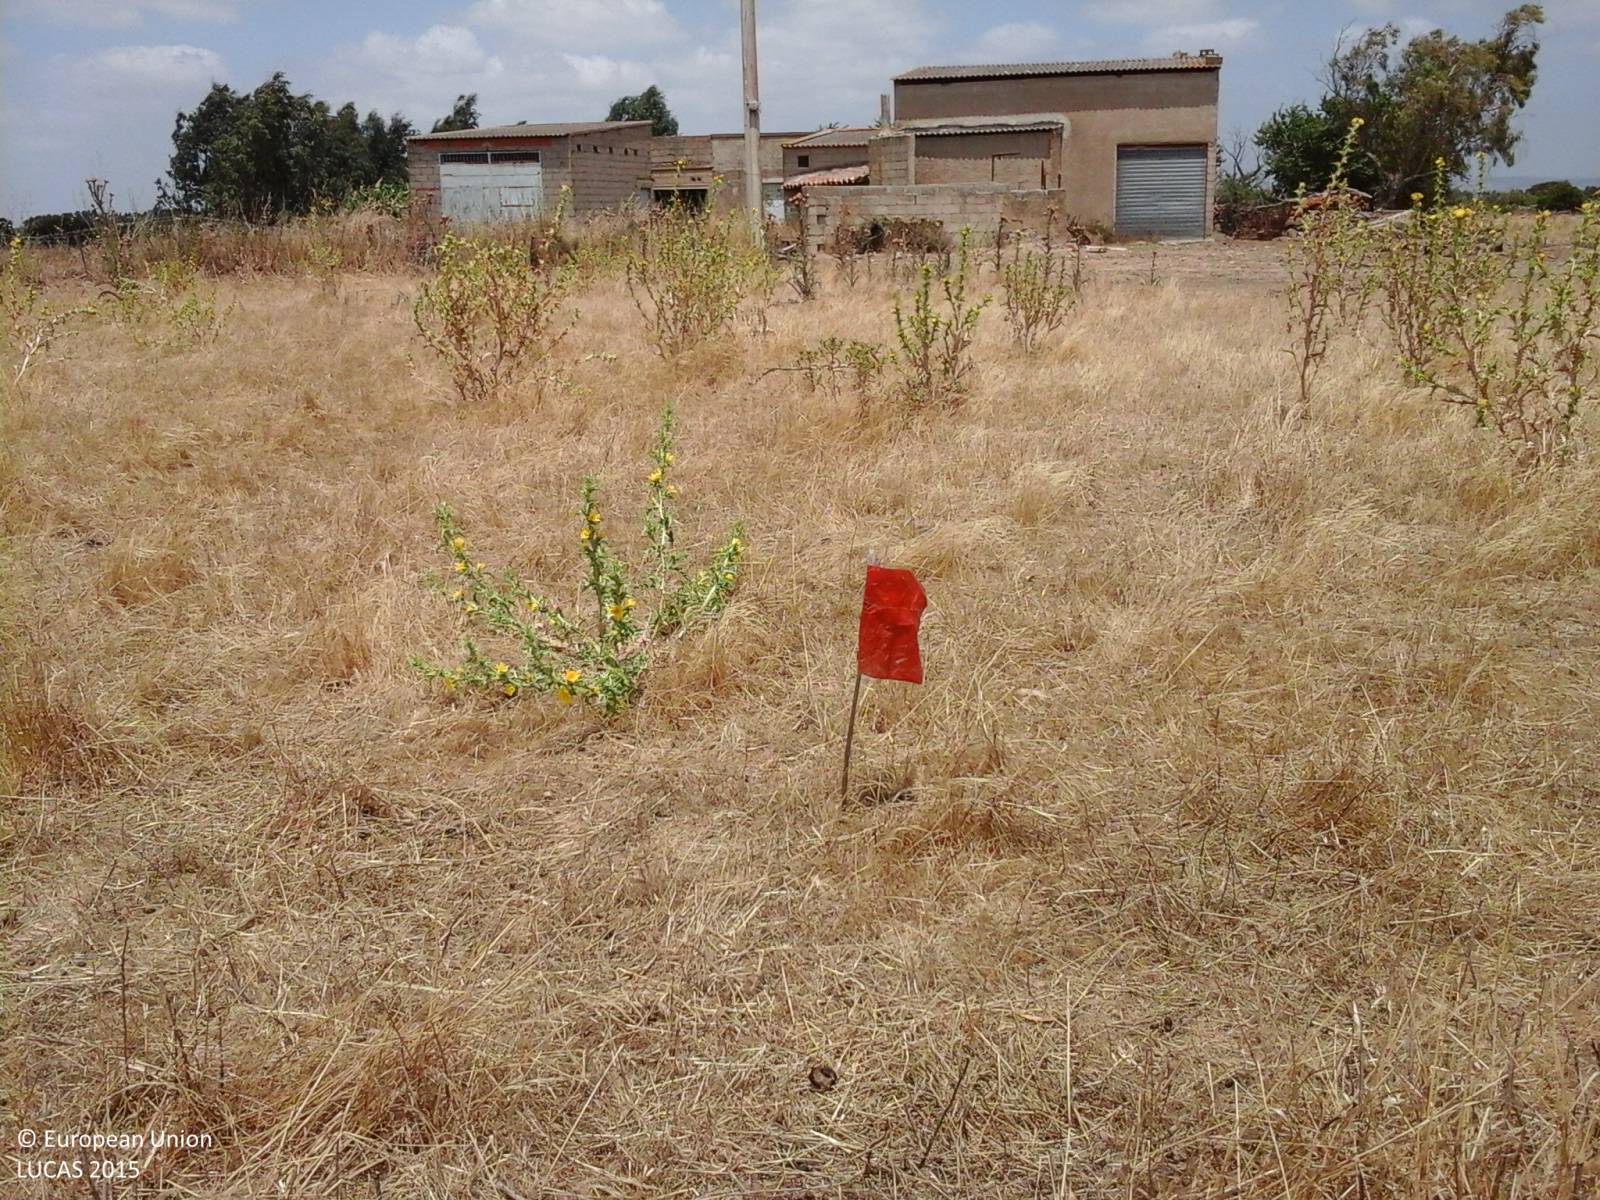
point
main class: Cropland
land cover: Mixed cereals for fodder
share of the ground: > 75 %
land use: Agriculture (excluding fallow land and kitchen gardens)
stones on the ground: < 10 %
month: June
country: IT
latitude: 39.6241
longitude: 8.6449
